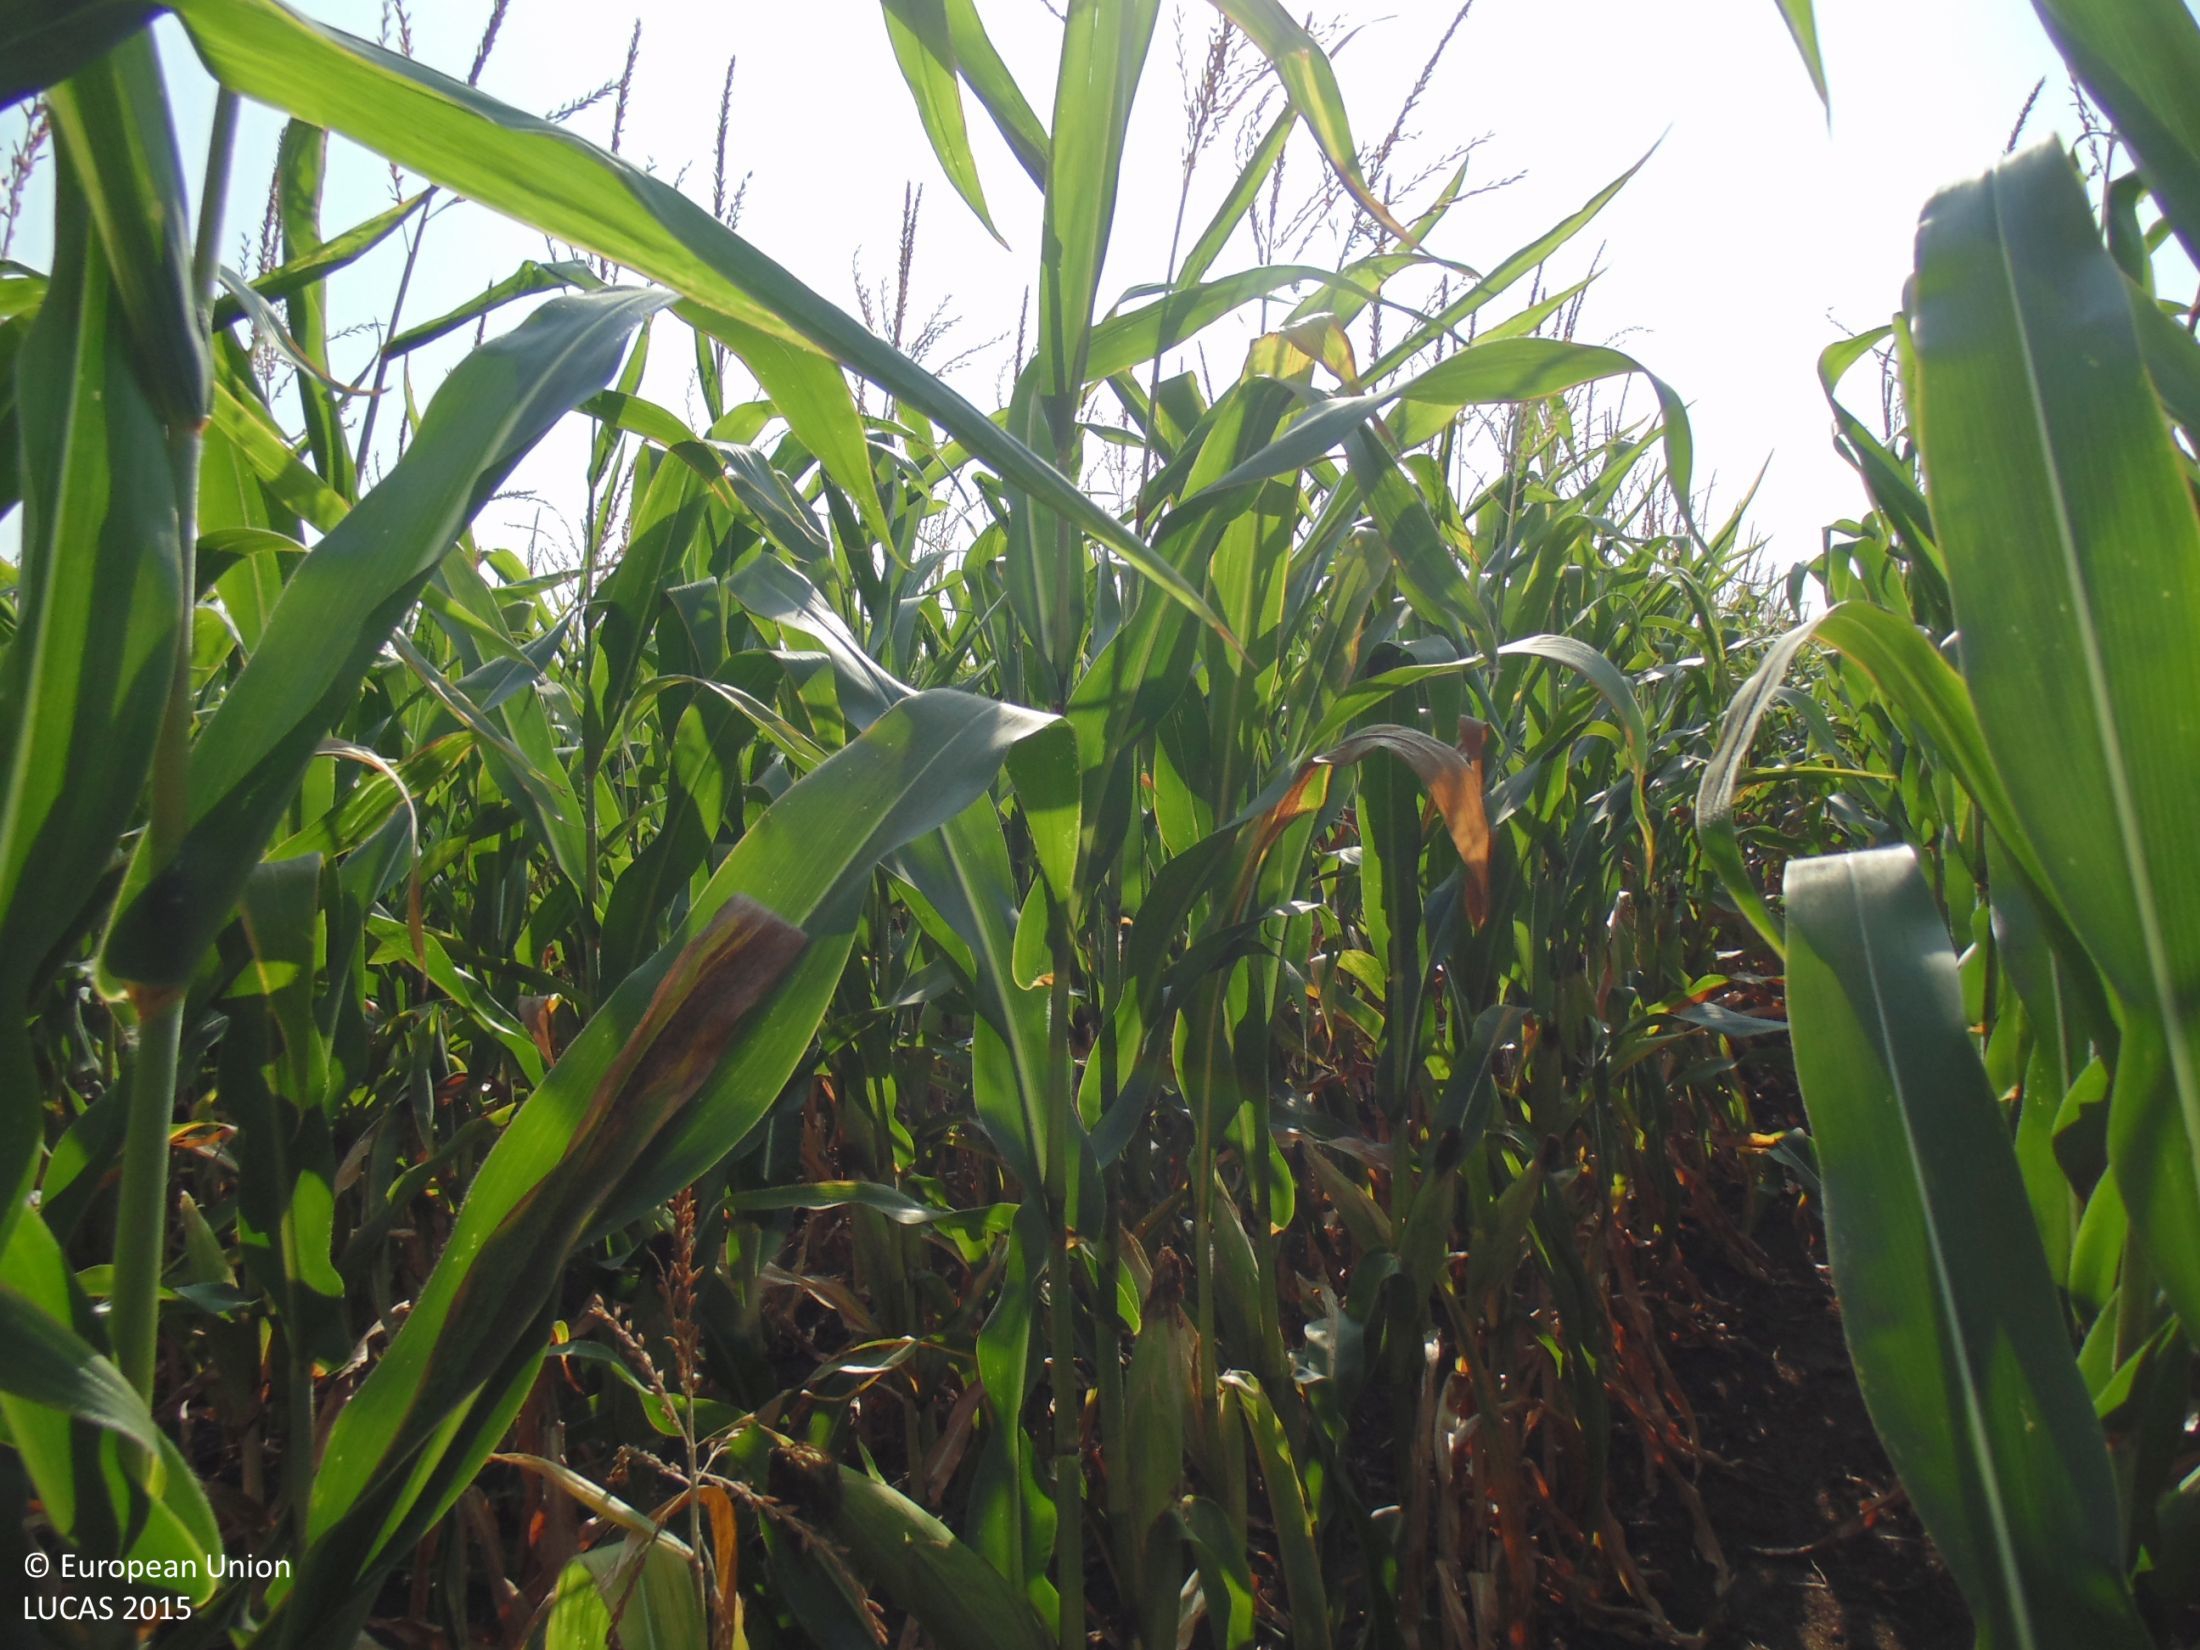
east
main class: Cropland
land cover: Maize
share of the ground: > 75 %
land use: Agriculture (excluding fallow land and kitchen gardens)
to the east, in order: Maize
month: August
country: BG
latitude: 43.8009
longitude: 28.0620
